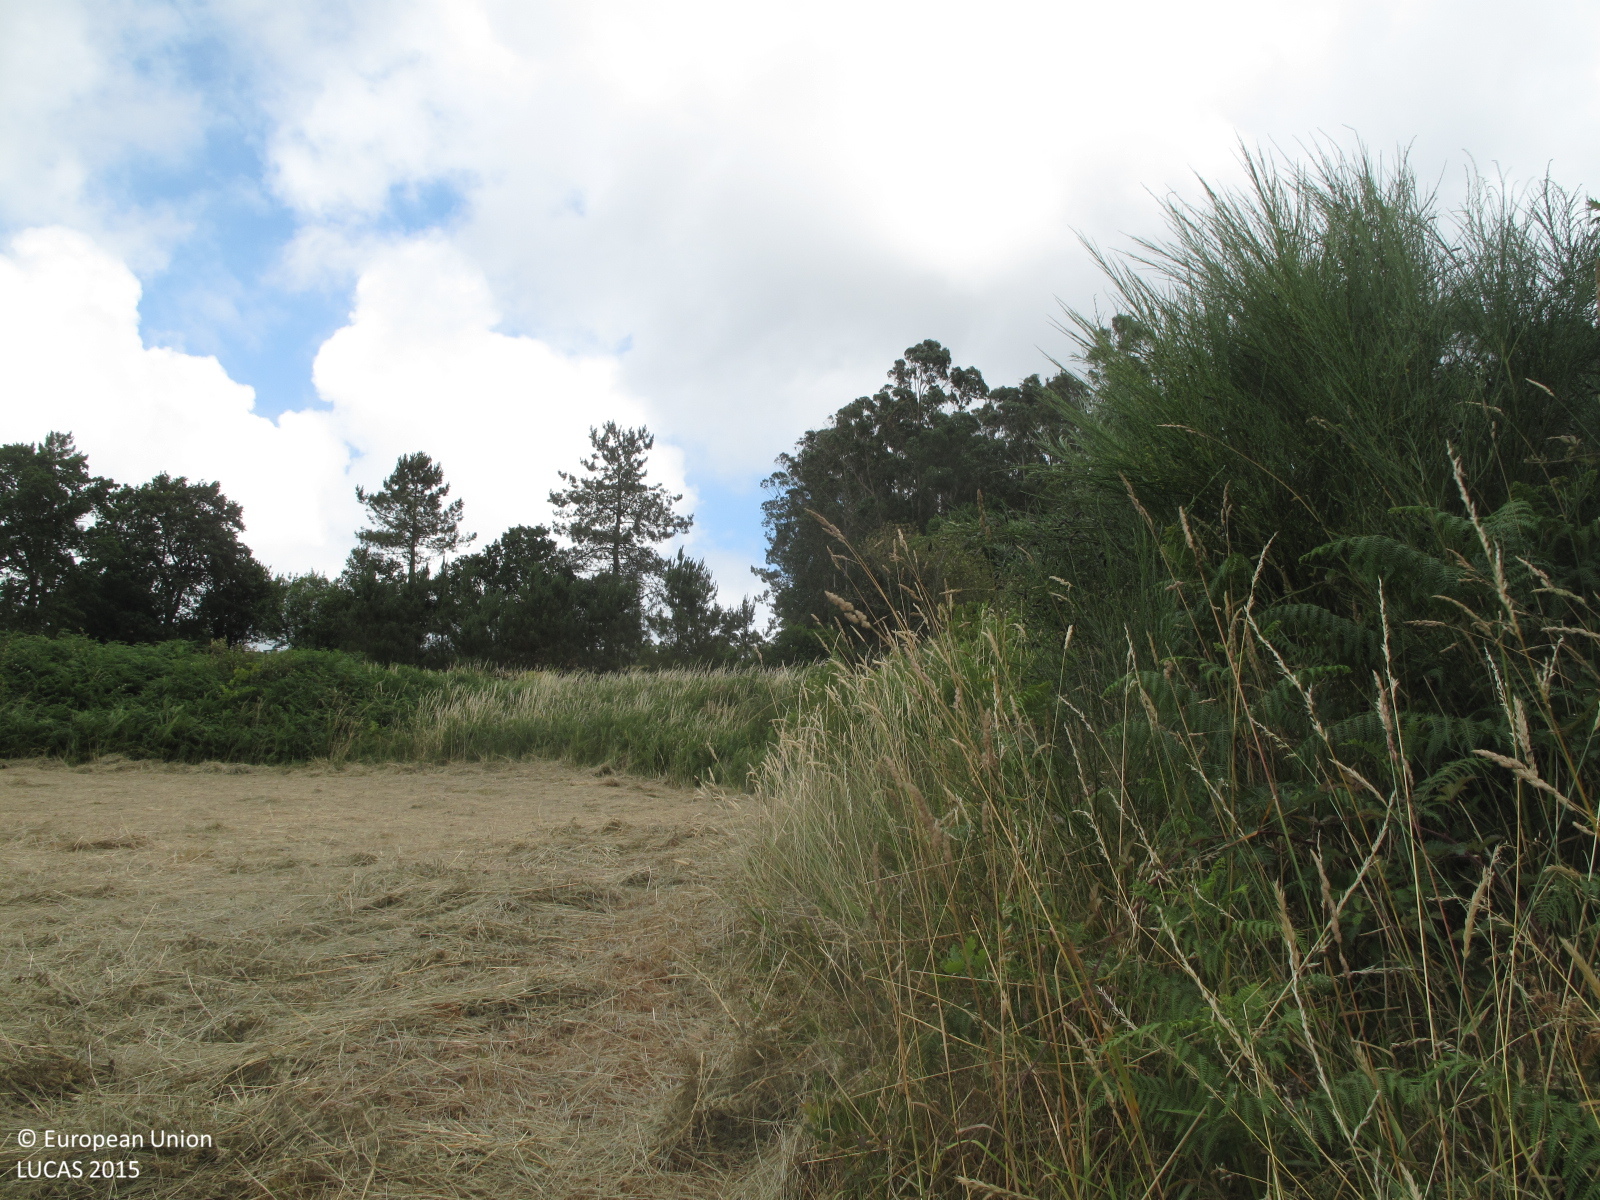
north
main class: Woodland
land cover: Broadleaved woodland
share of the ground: 50 - 75 %
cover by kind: broadleaved forest trees 70 %, shrubs 20 %, herbaceous plants 10 %
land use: Forestry
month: July
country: ES
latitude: 43.4608
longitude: -8.1066
